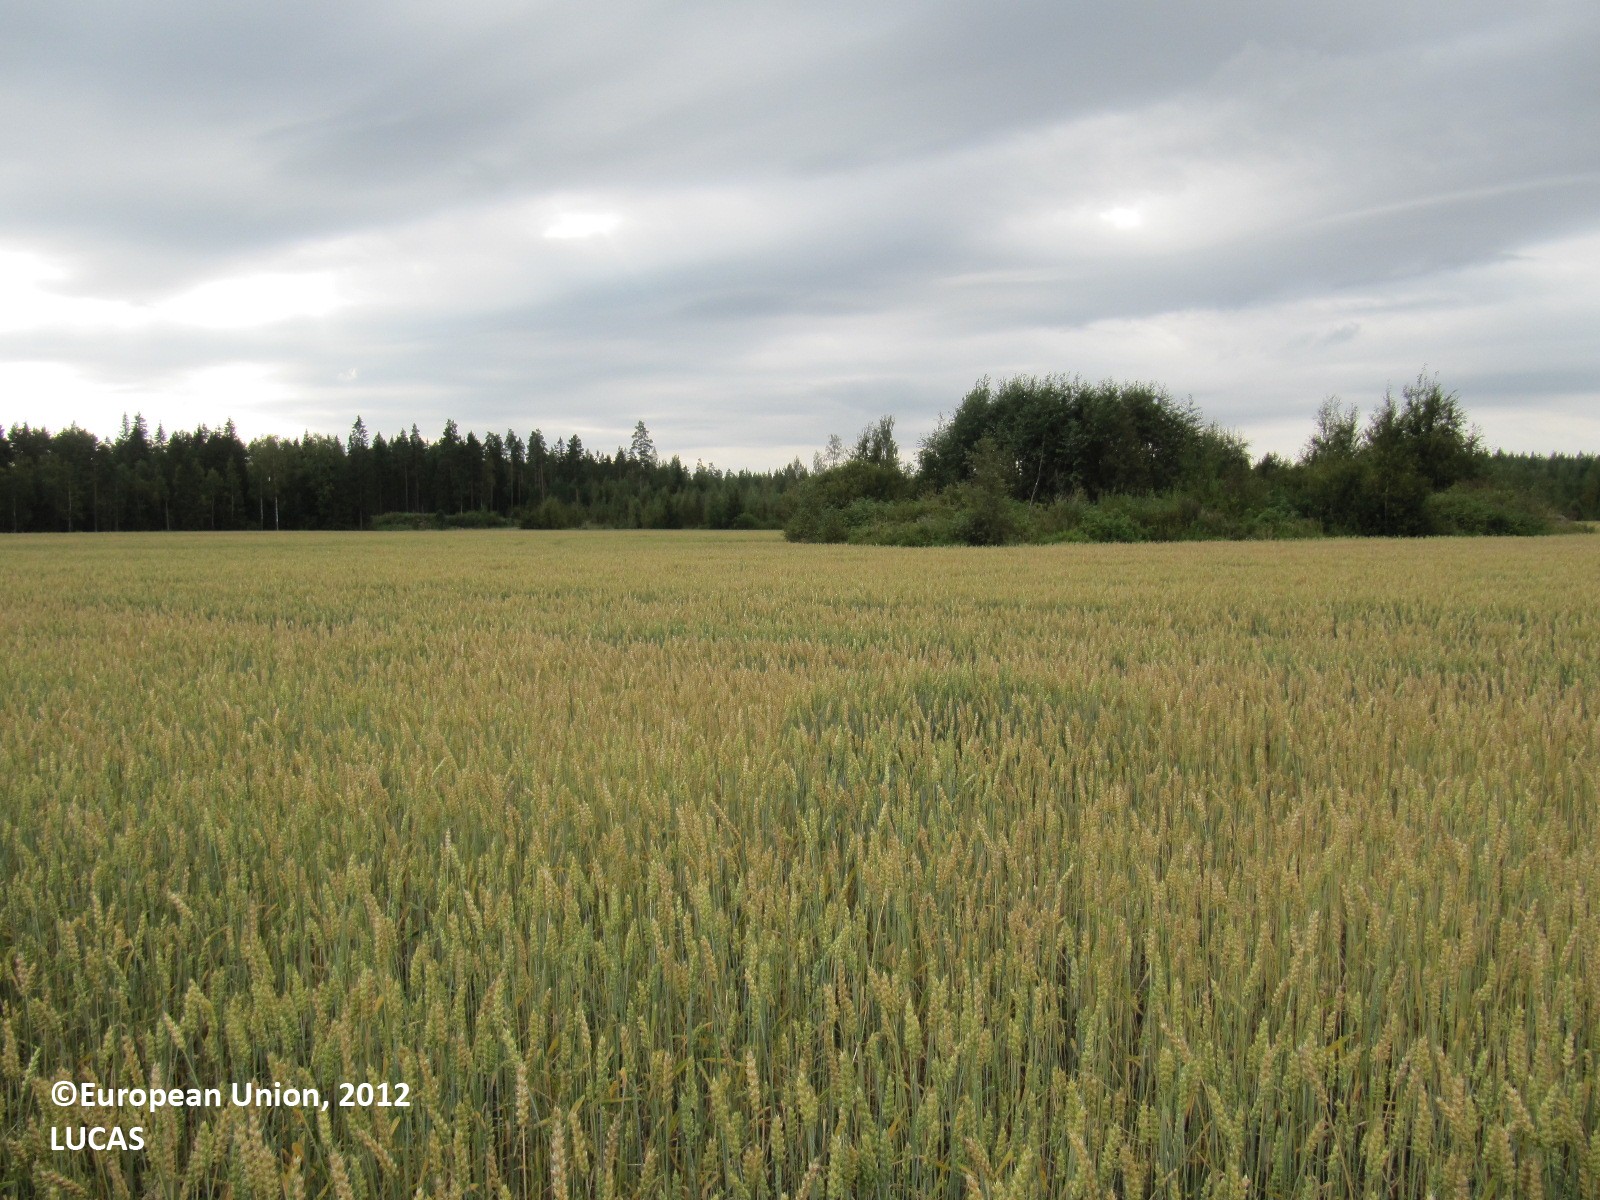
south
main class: Cropland
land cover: Common wheat
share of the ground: > 75 %
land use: Agriculture (excluding fallow land and kitchen gardens)
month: August
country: FI
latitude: 61.0970
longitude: 22.9638
